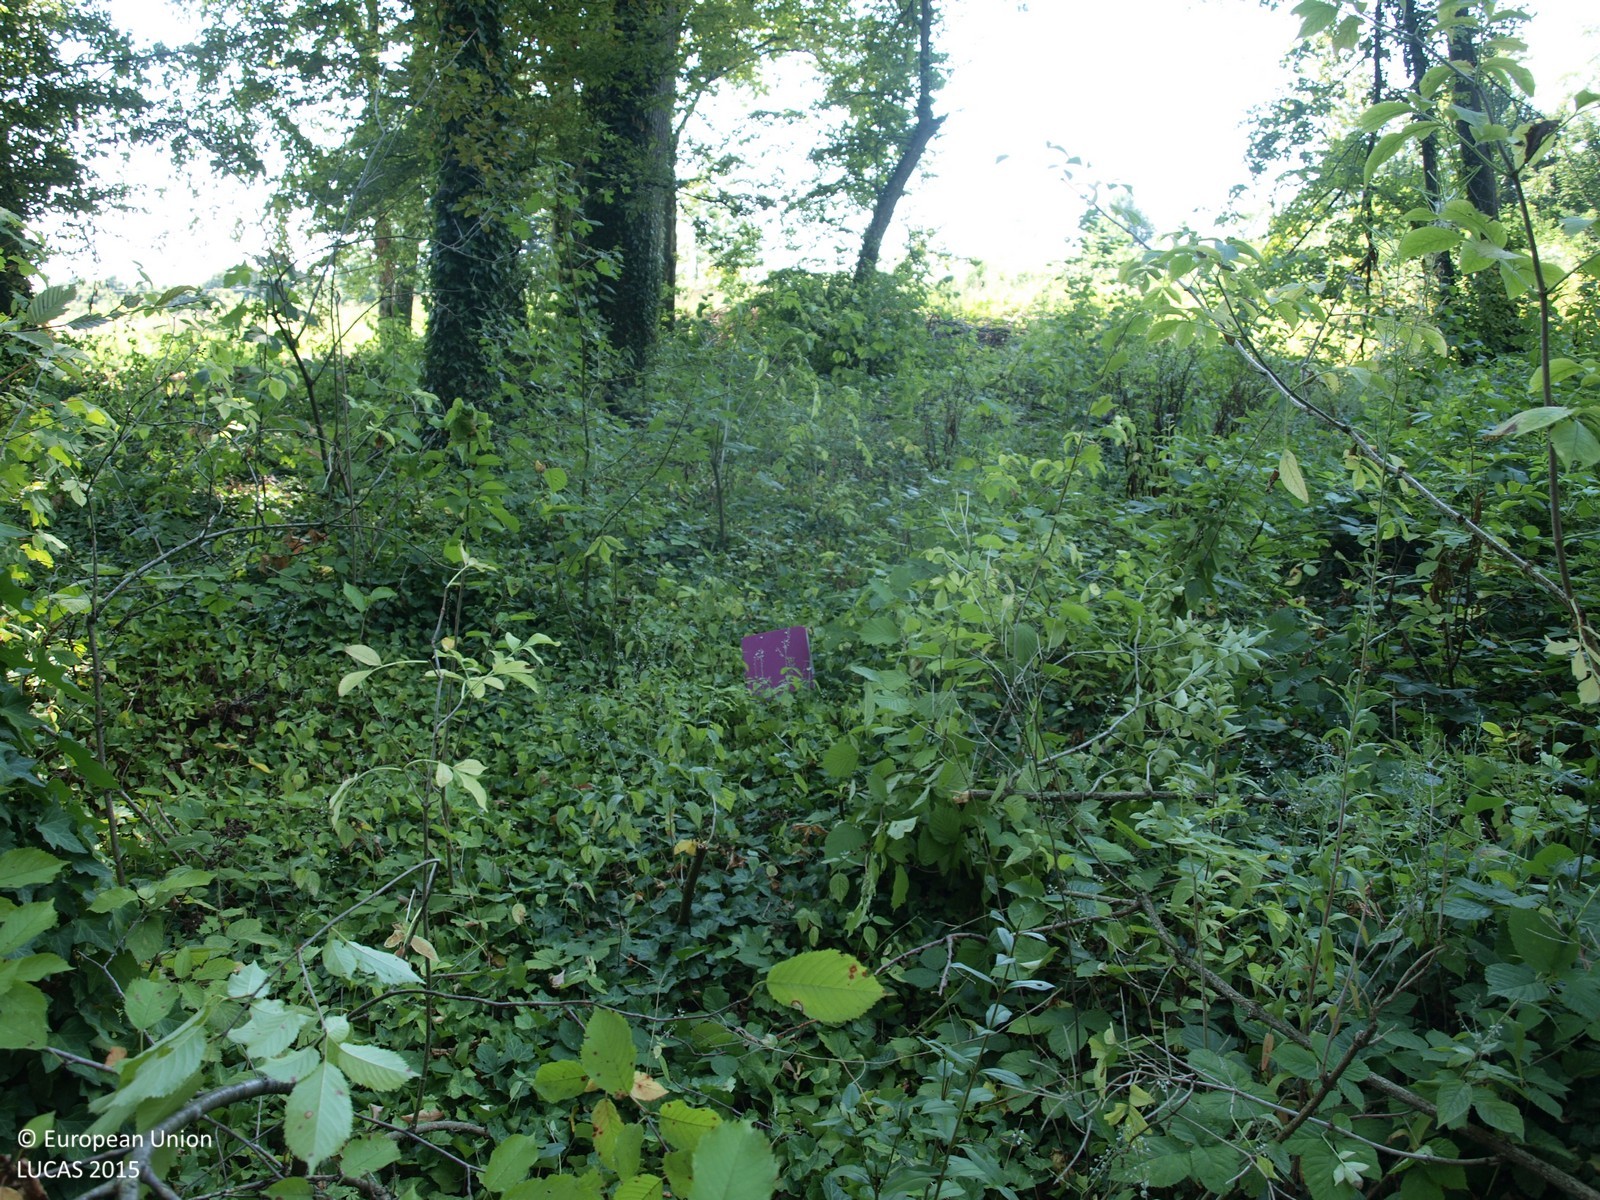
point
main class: Woodland
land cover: Broadleaved woodland
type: mesophytic deciduous forest
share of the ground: > 75 %
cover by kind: broadleaved forest trees 100 %
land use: Forestry
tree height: > 5 m
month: August
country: HR
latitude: 46.0255
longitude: 16.5236
